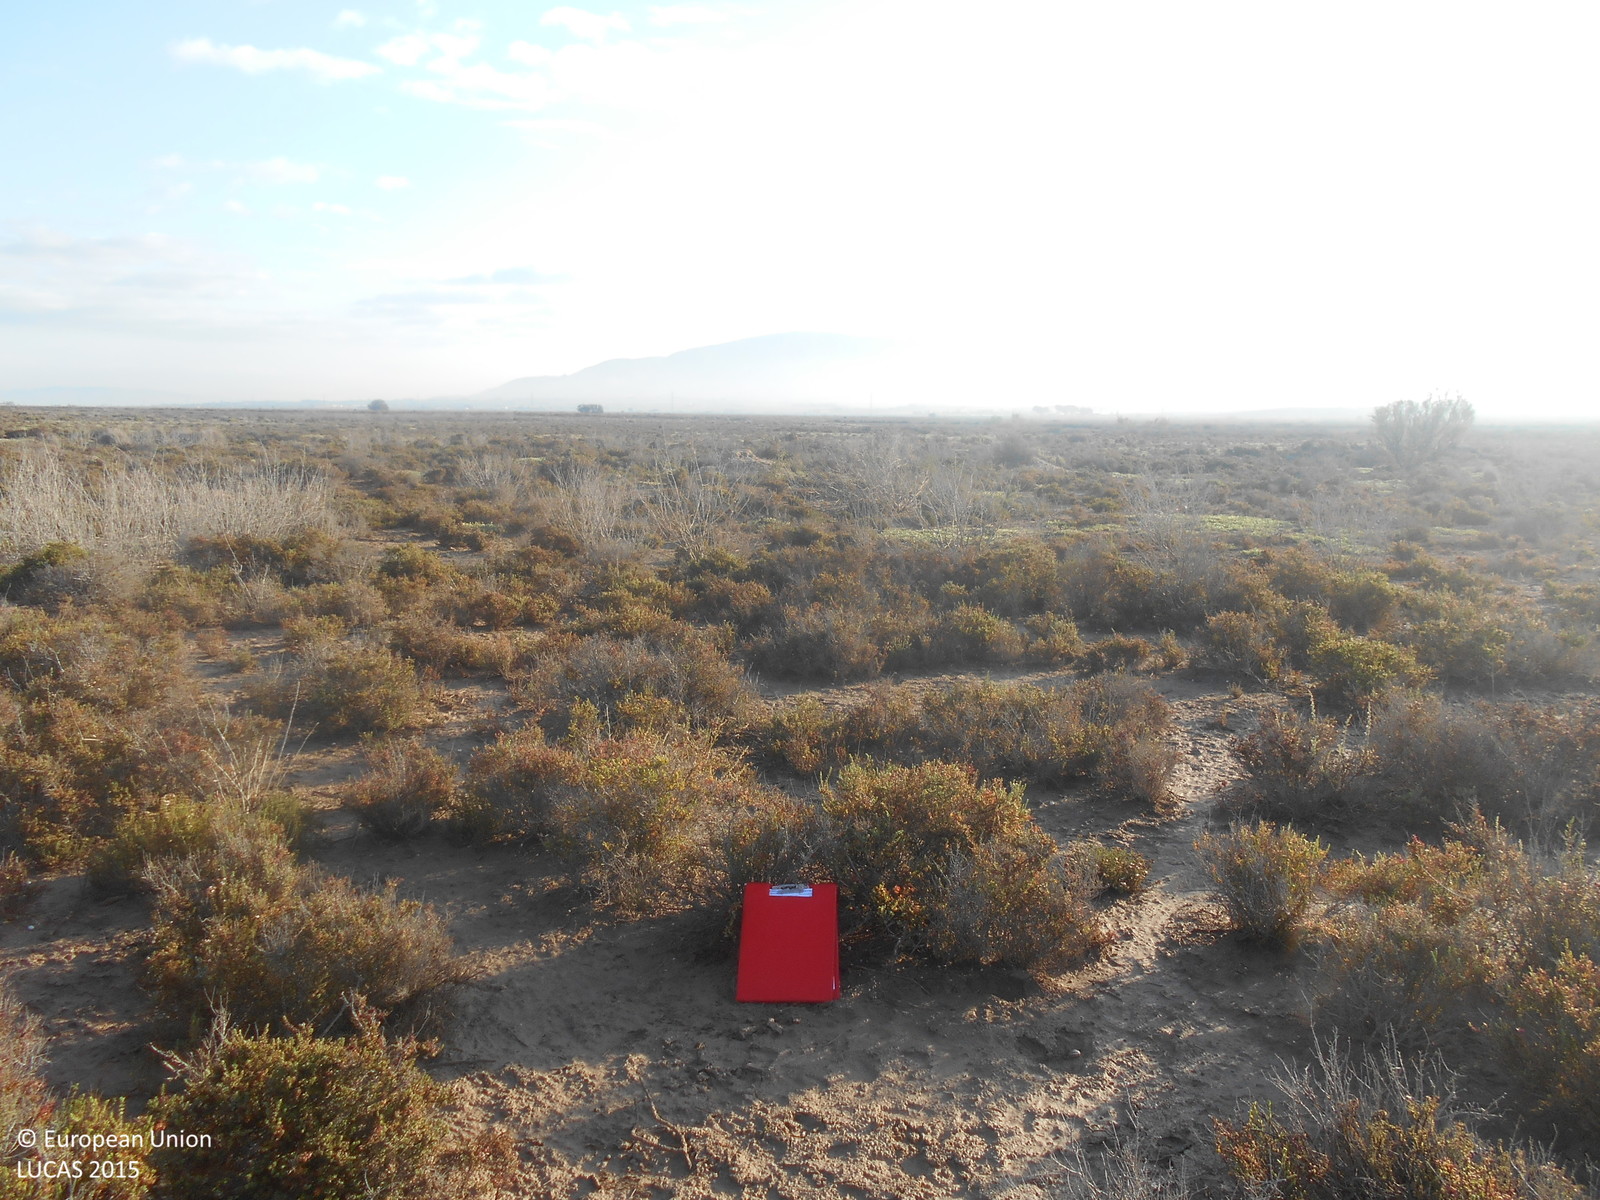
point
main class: Shrubland
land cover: Shrubland without tree cover
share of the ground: 50 - 75 %
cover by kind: shrubs 60 %, unconsolidated bare surface 40 %
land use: Semi-natural and natural areas not in use
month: April
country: ES
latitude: 37.7382
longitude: -1.3863
